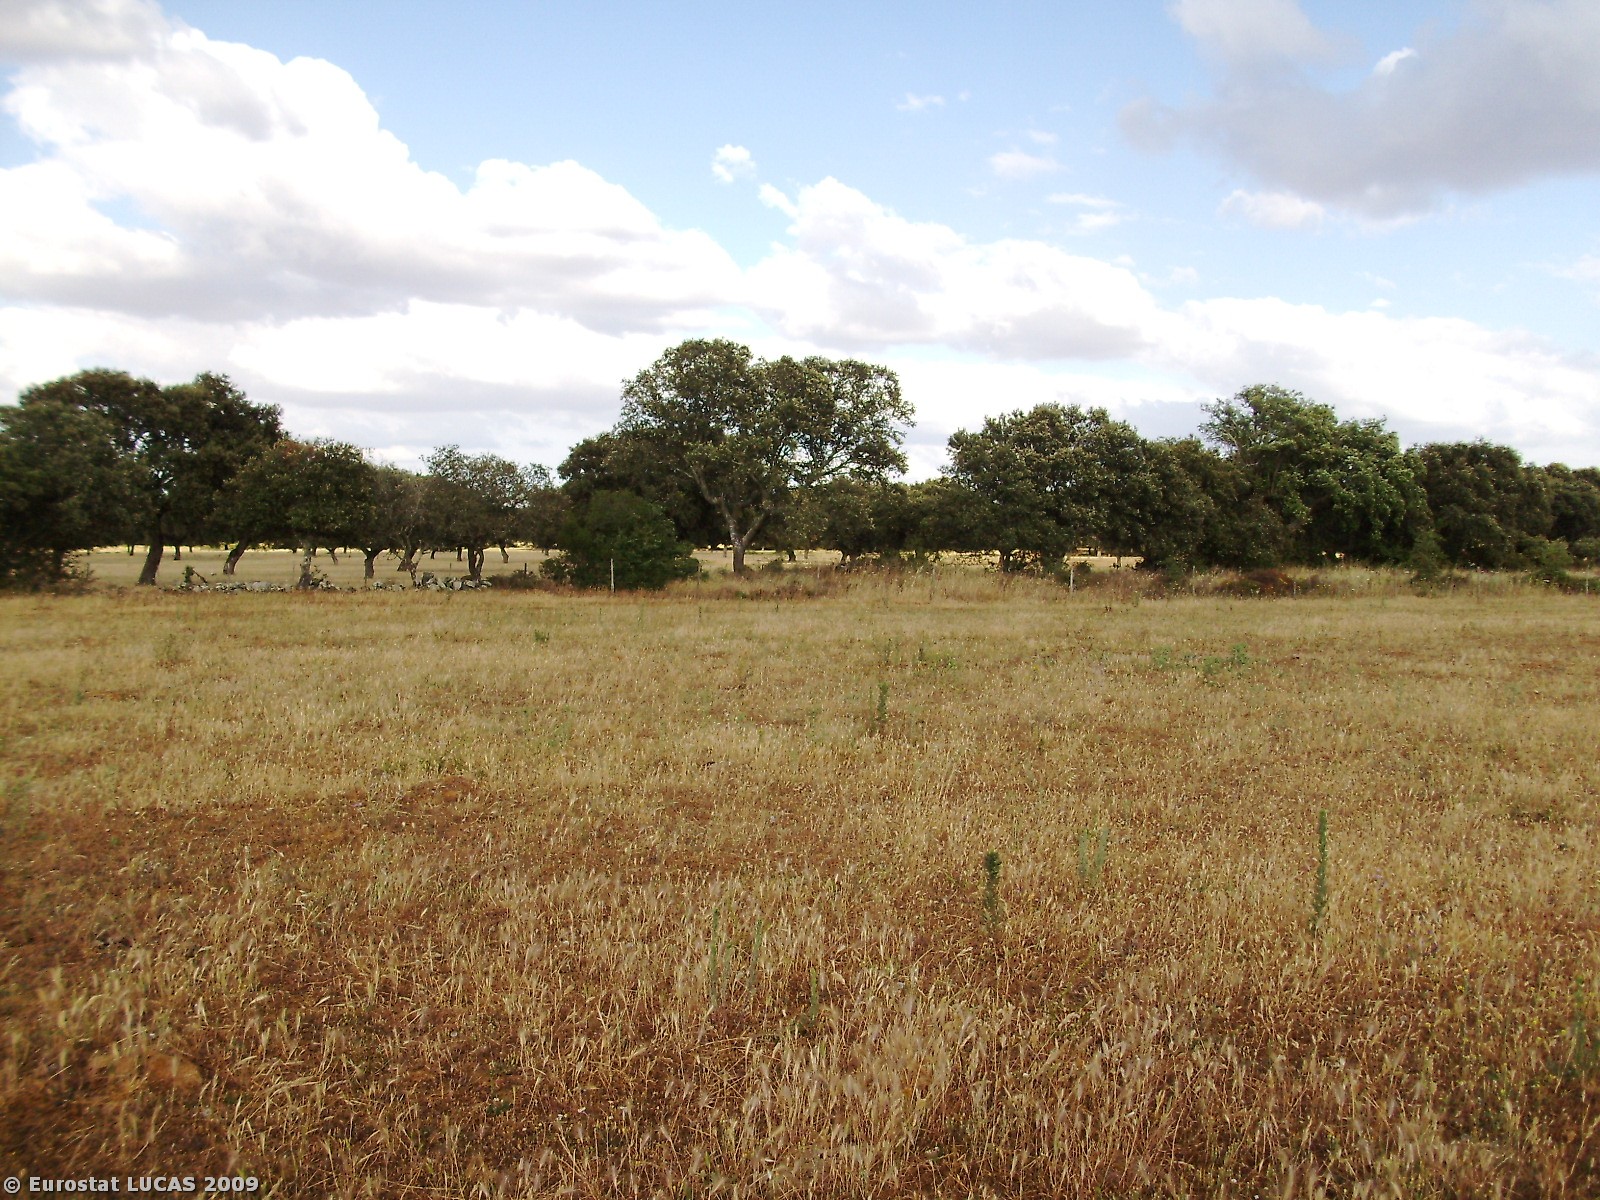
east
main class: Grassland
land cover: Grassland with sparse tree/shrub cover
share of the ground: > 75 %
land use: Agriculture (excluding fallow land and kitchen gardens)
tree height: > 5 m
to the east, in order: Grassland with sparse tree/shrub cover; Fences; Lines of trees; Fences; Broadleaved woodland
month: June
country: PT
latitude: 38.9288
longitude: -7.2528
